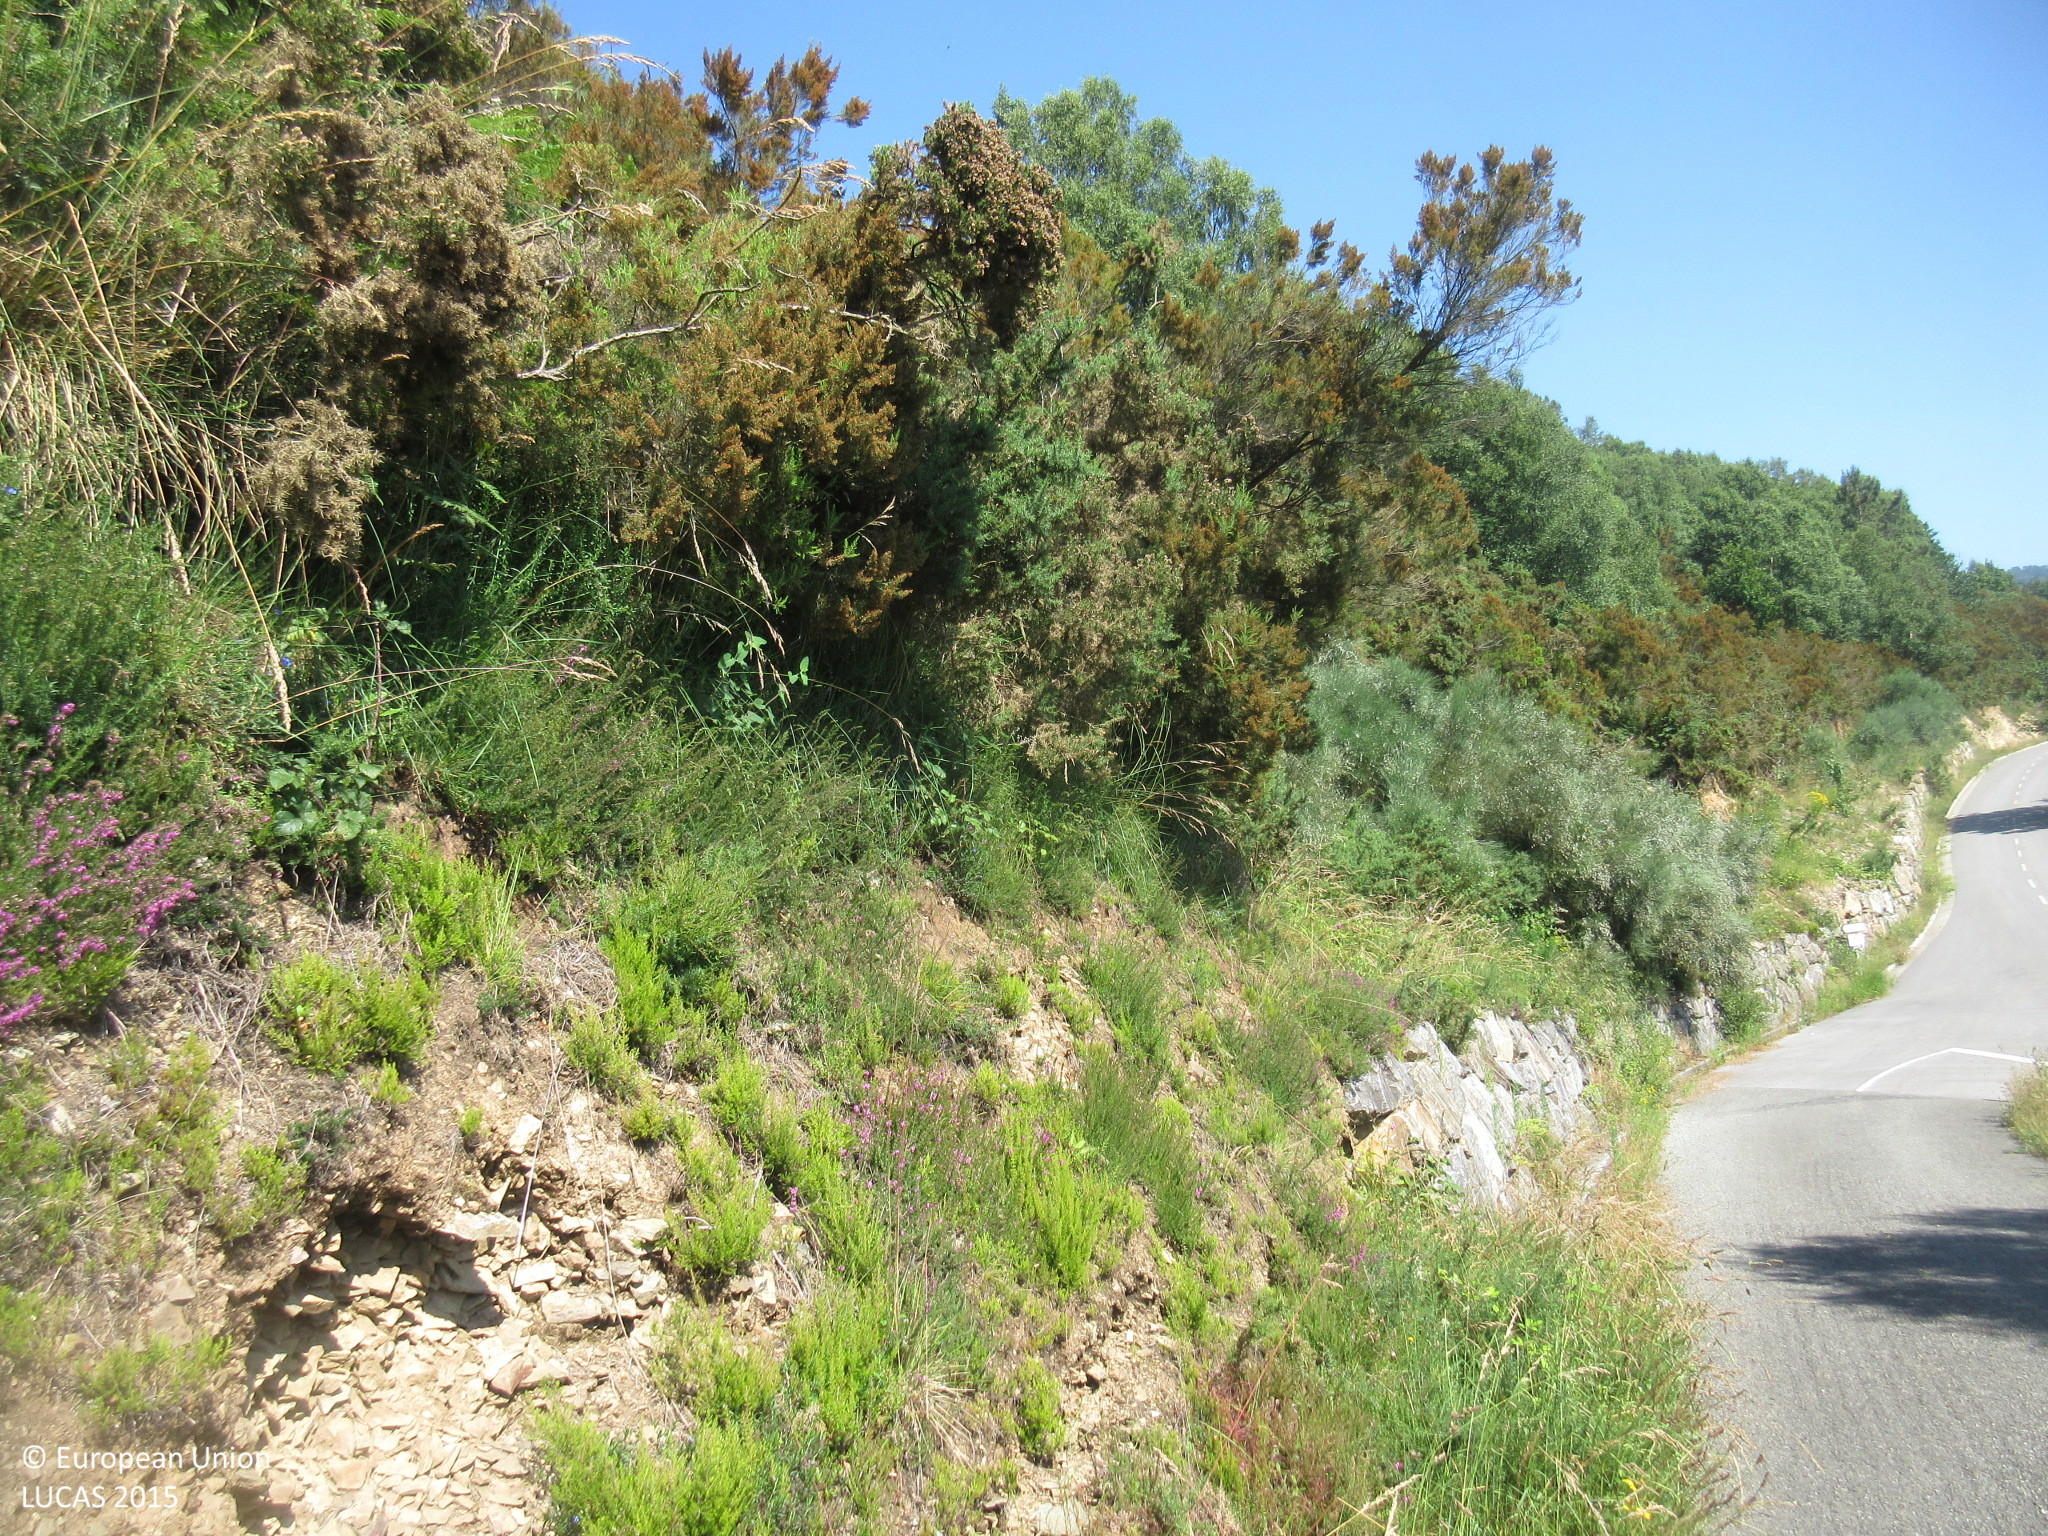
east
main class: Shrubland
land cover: Shrubland with sparse tree cover
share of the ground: > 75 %
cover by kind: shrubs 95 %, broadleaved forest trees 5 %
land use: Forestry
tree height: > 5 m
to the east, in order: Shrubland with sparse tree cover; Broadleaved woodland
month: June
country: ES
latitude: 43.3275
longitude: -7.0743
